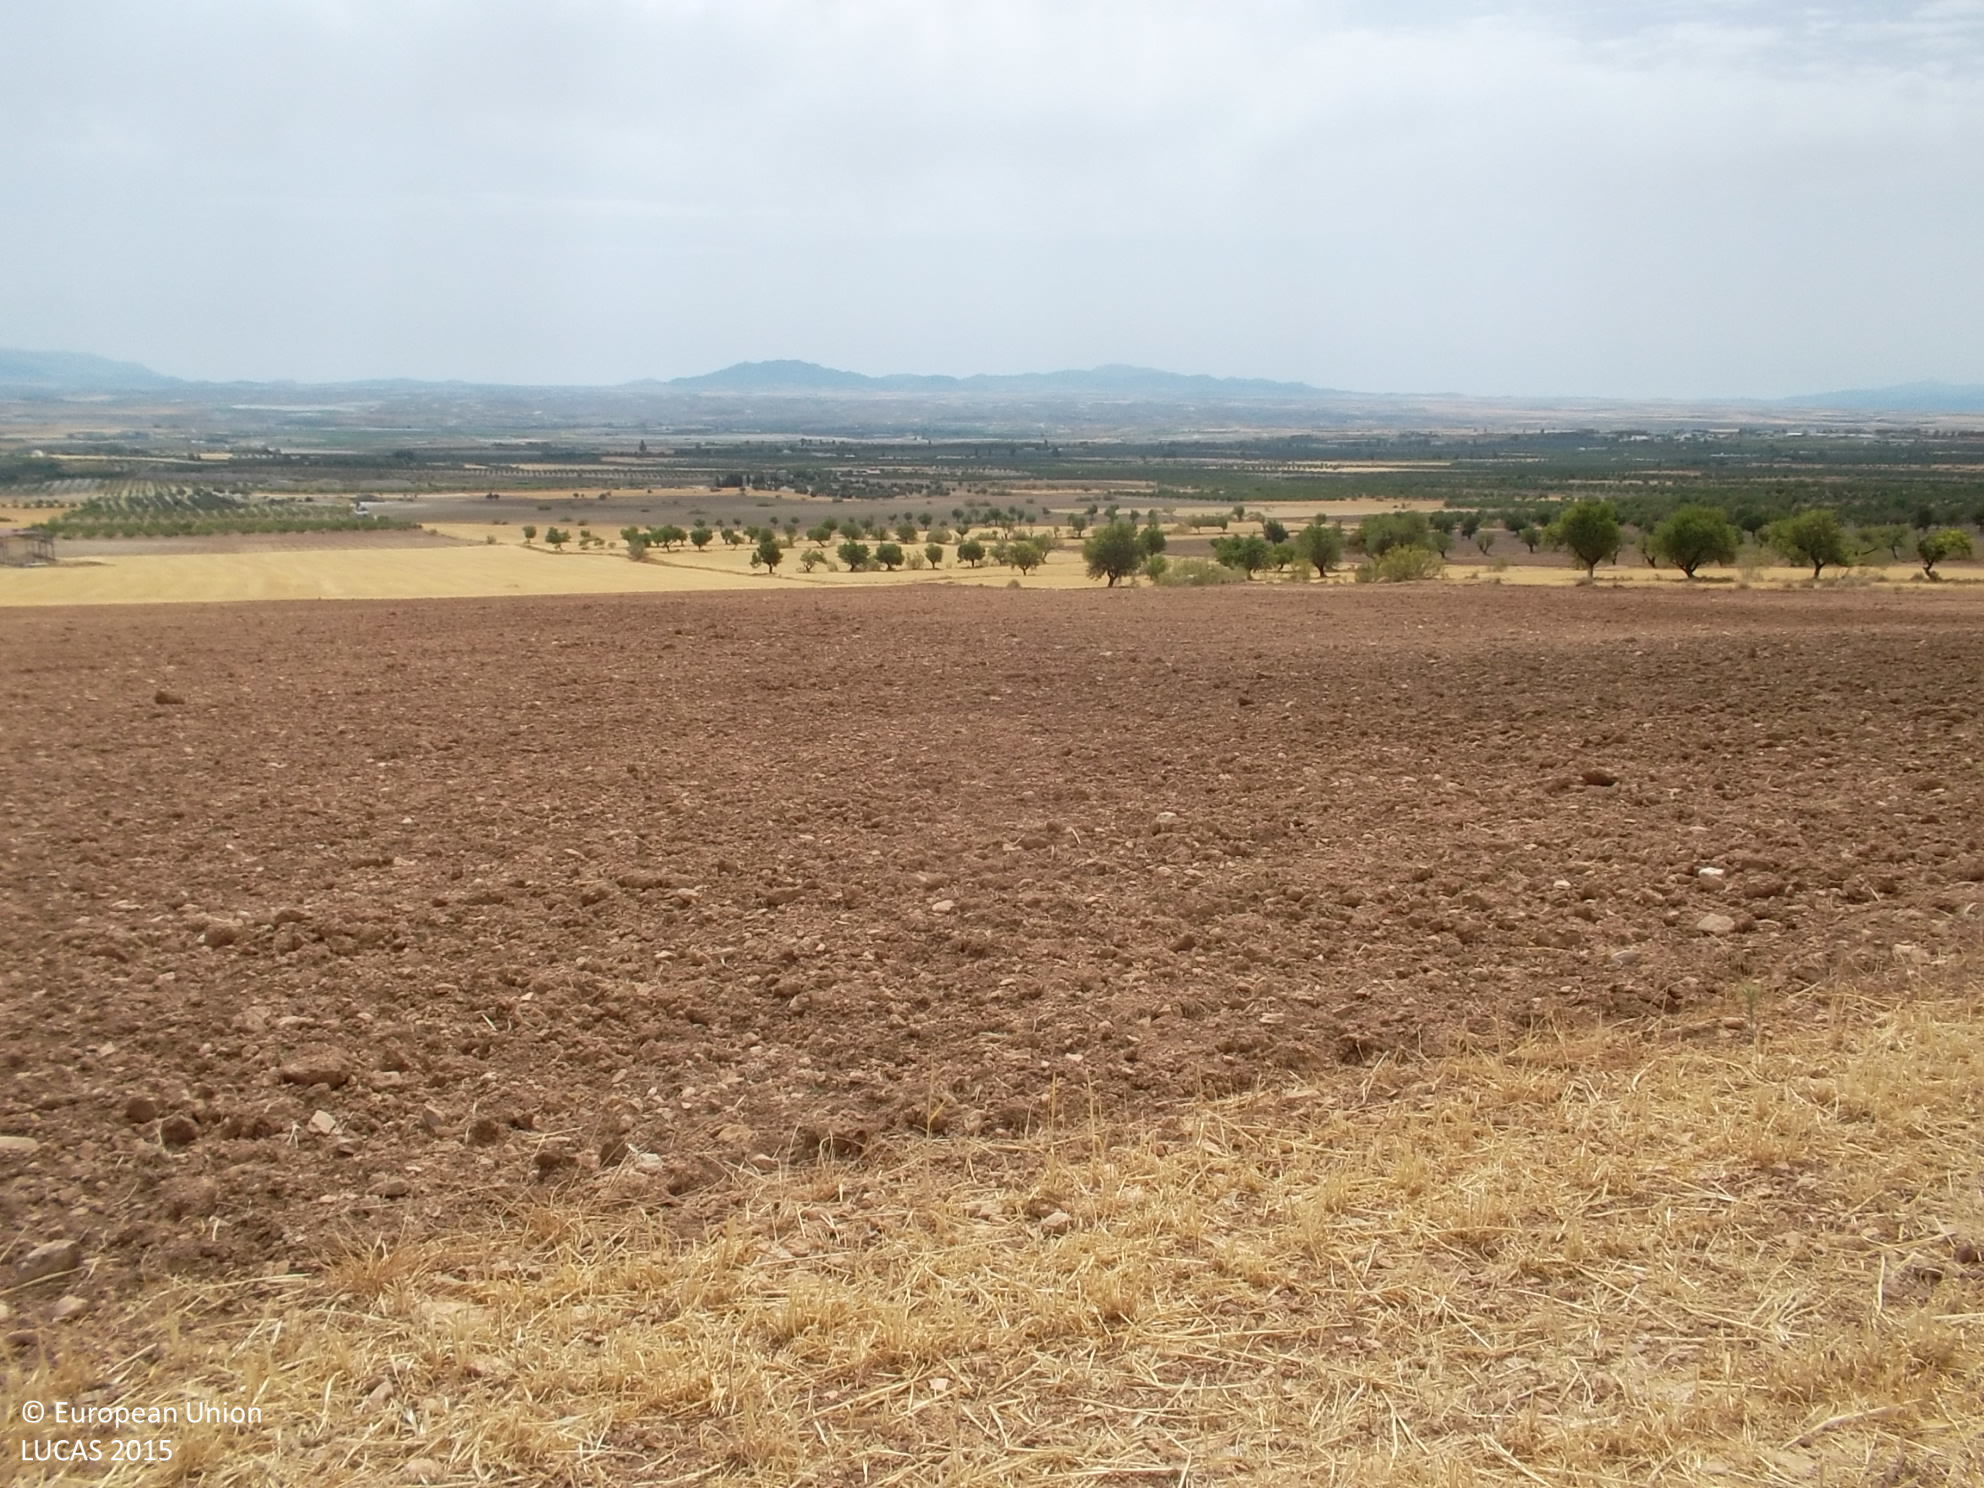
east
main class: Cropland
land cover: Oats
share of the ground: > 75 %
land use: Agriculture (excluding fallow land and kitchen gardens)
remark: Harvested field
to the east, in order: Oats; Other bare soil; Barley
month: July
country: ES
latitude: 37.5583
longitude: -2.7915
